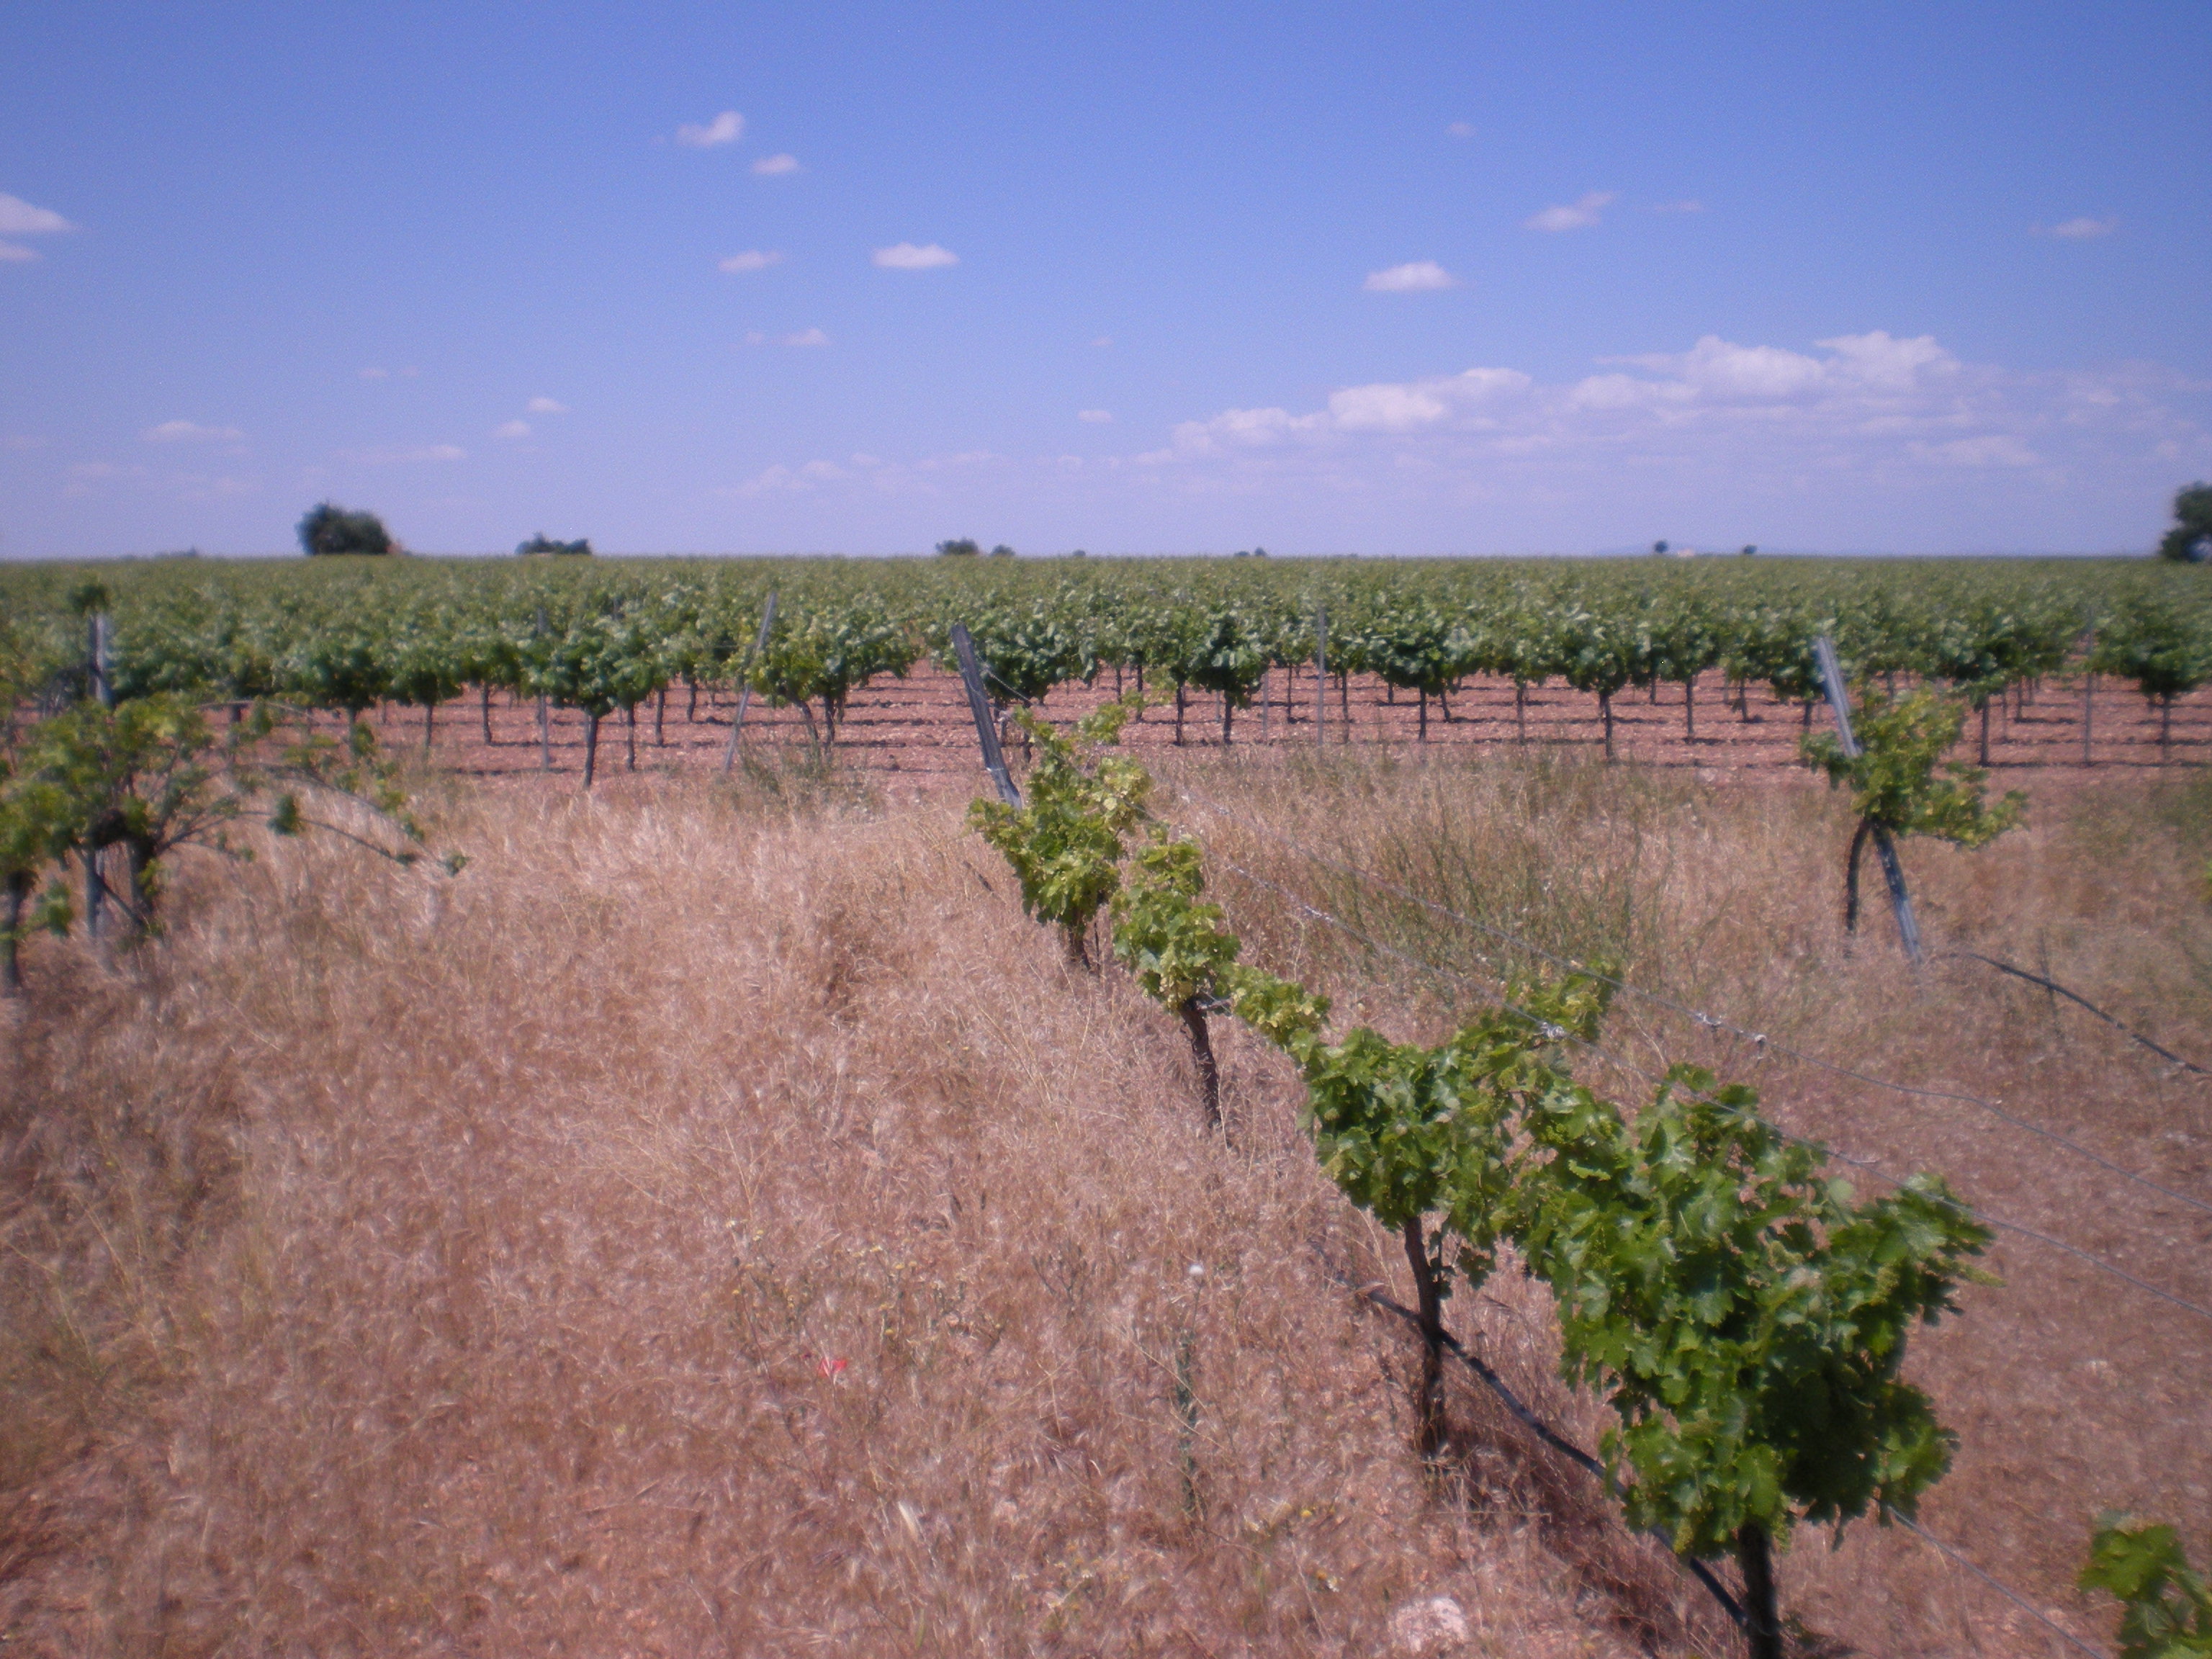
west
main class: Artificial land
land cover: Other artificial areas
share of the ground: < 10 %
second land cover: Vineyards
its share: 10 - 25 %
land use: Electricity, gas and thermal power distribution
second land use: Agriculture (excluding fallow land and kitchen gardens)
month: May
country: ES
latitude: 39.0996
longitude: -3.4410
